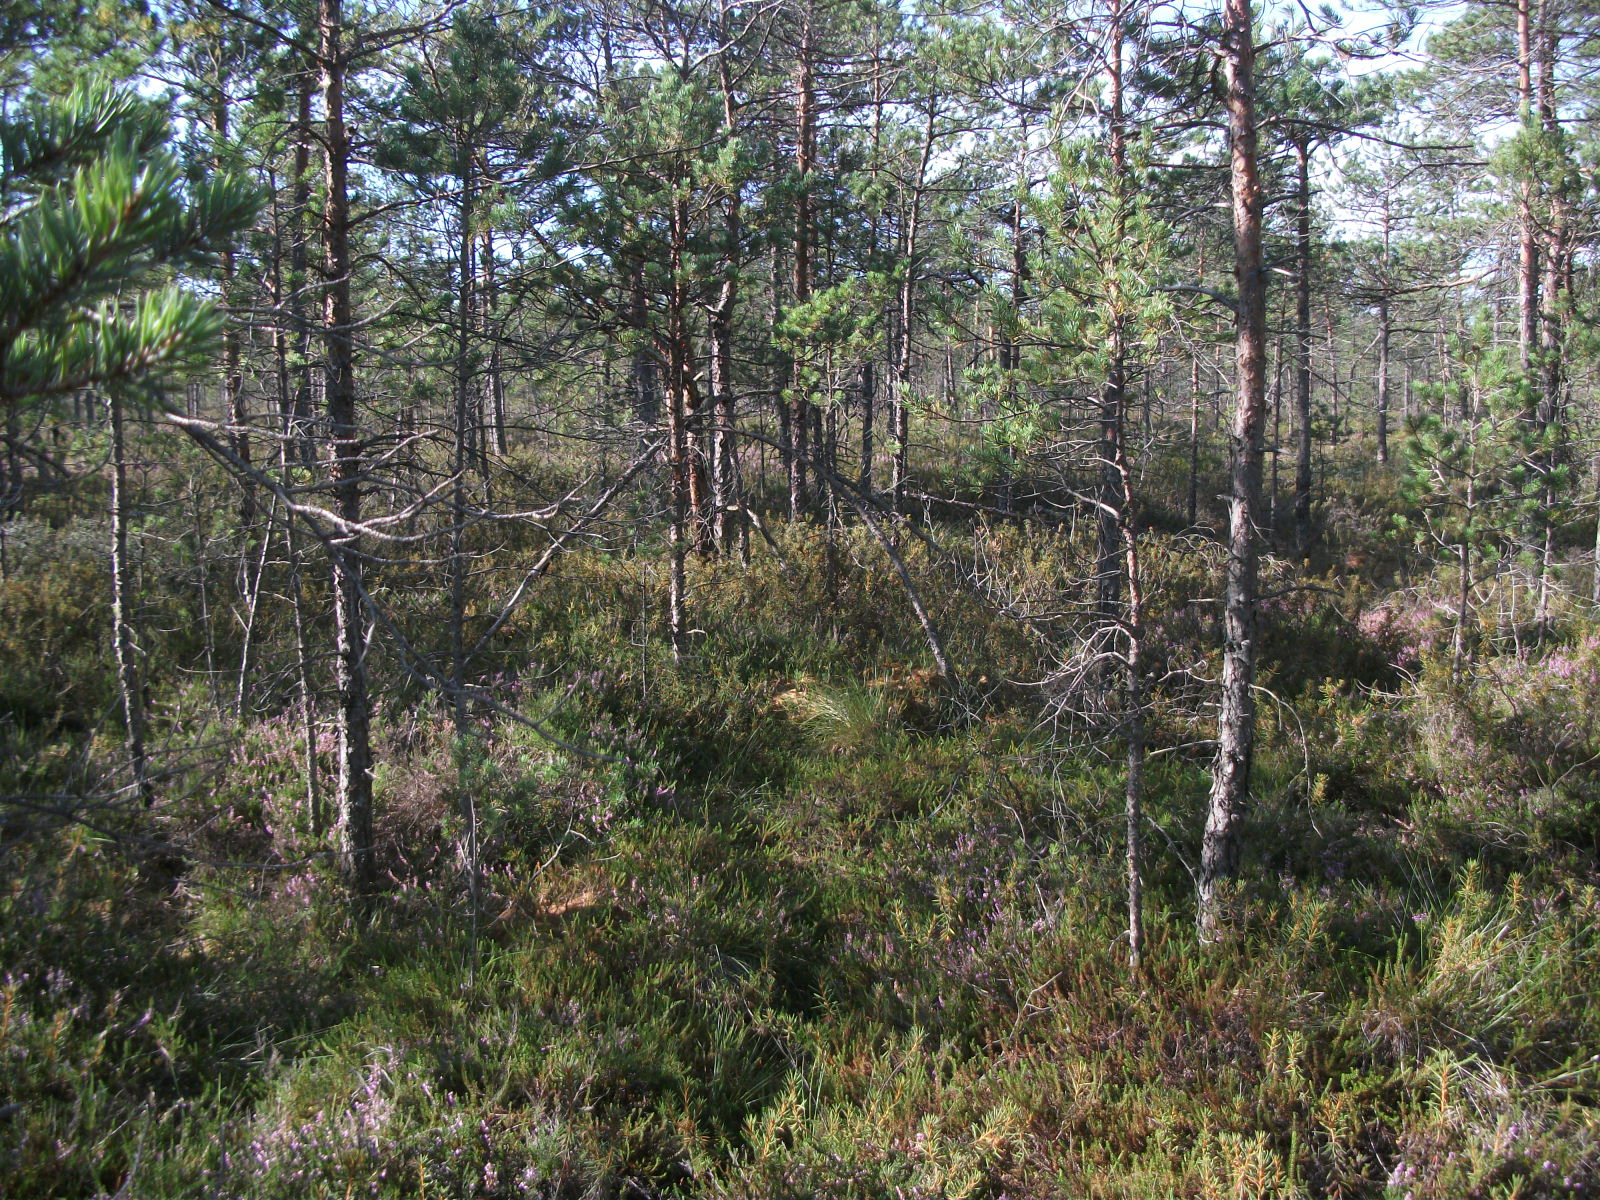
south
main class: Woodland
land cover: Pine dominated coniferous woodland
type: hemiboreal forest and nemoral coniferous forest and mixed broadleaved-coniferous forest
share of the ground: 50 - 75 %
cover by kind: coniferous forest trees 65 %, lichens and mosses 30 %, herbaceous plants 5 %
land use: Semi-natural and natural areas not in use
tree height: < 5 m
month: August
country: LV
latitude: 56.4204
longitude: 26.1717
